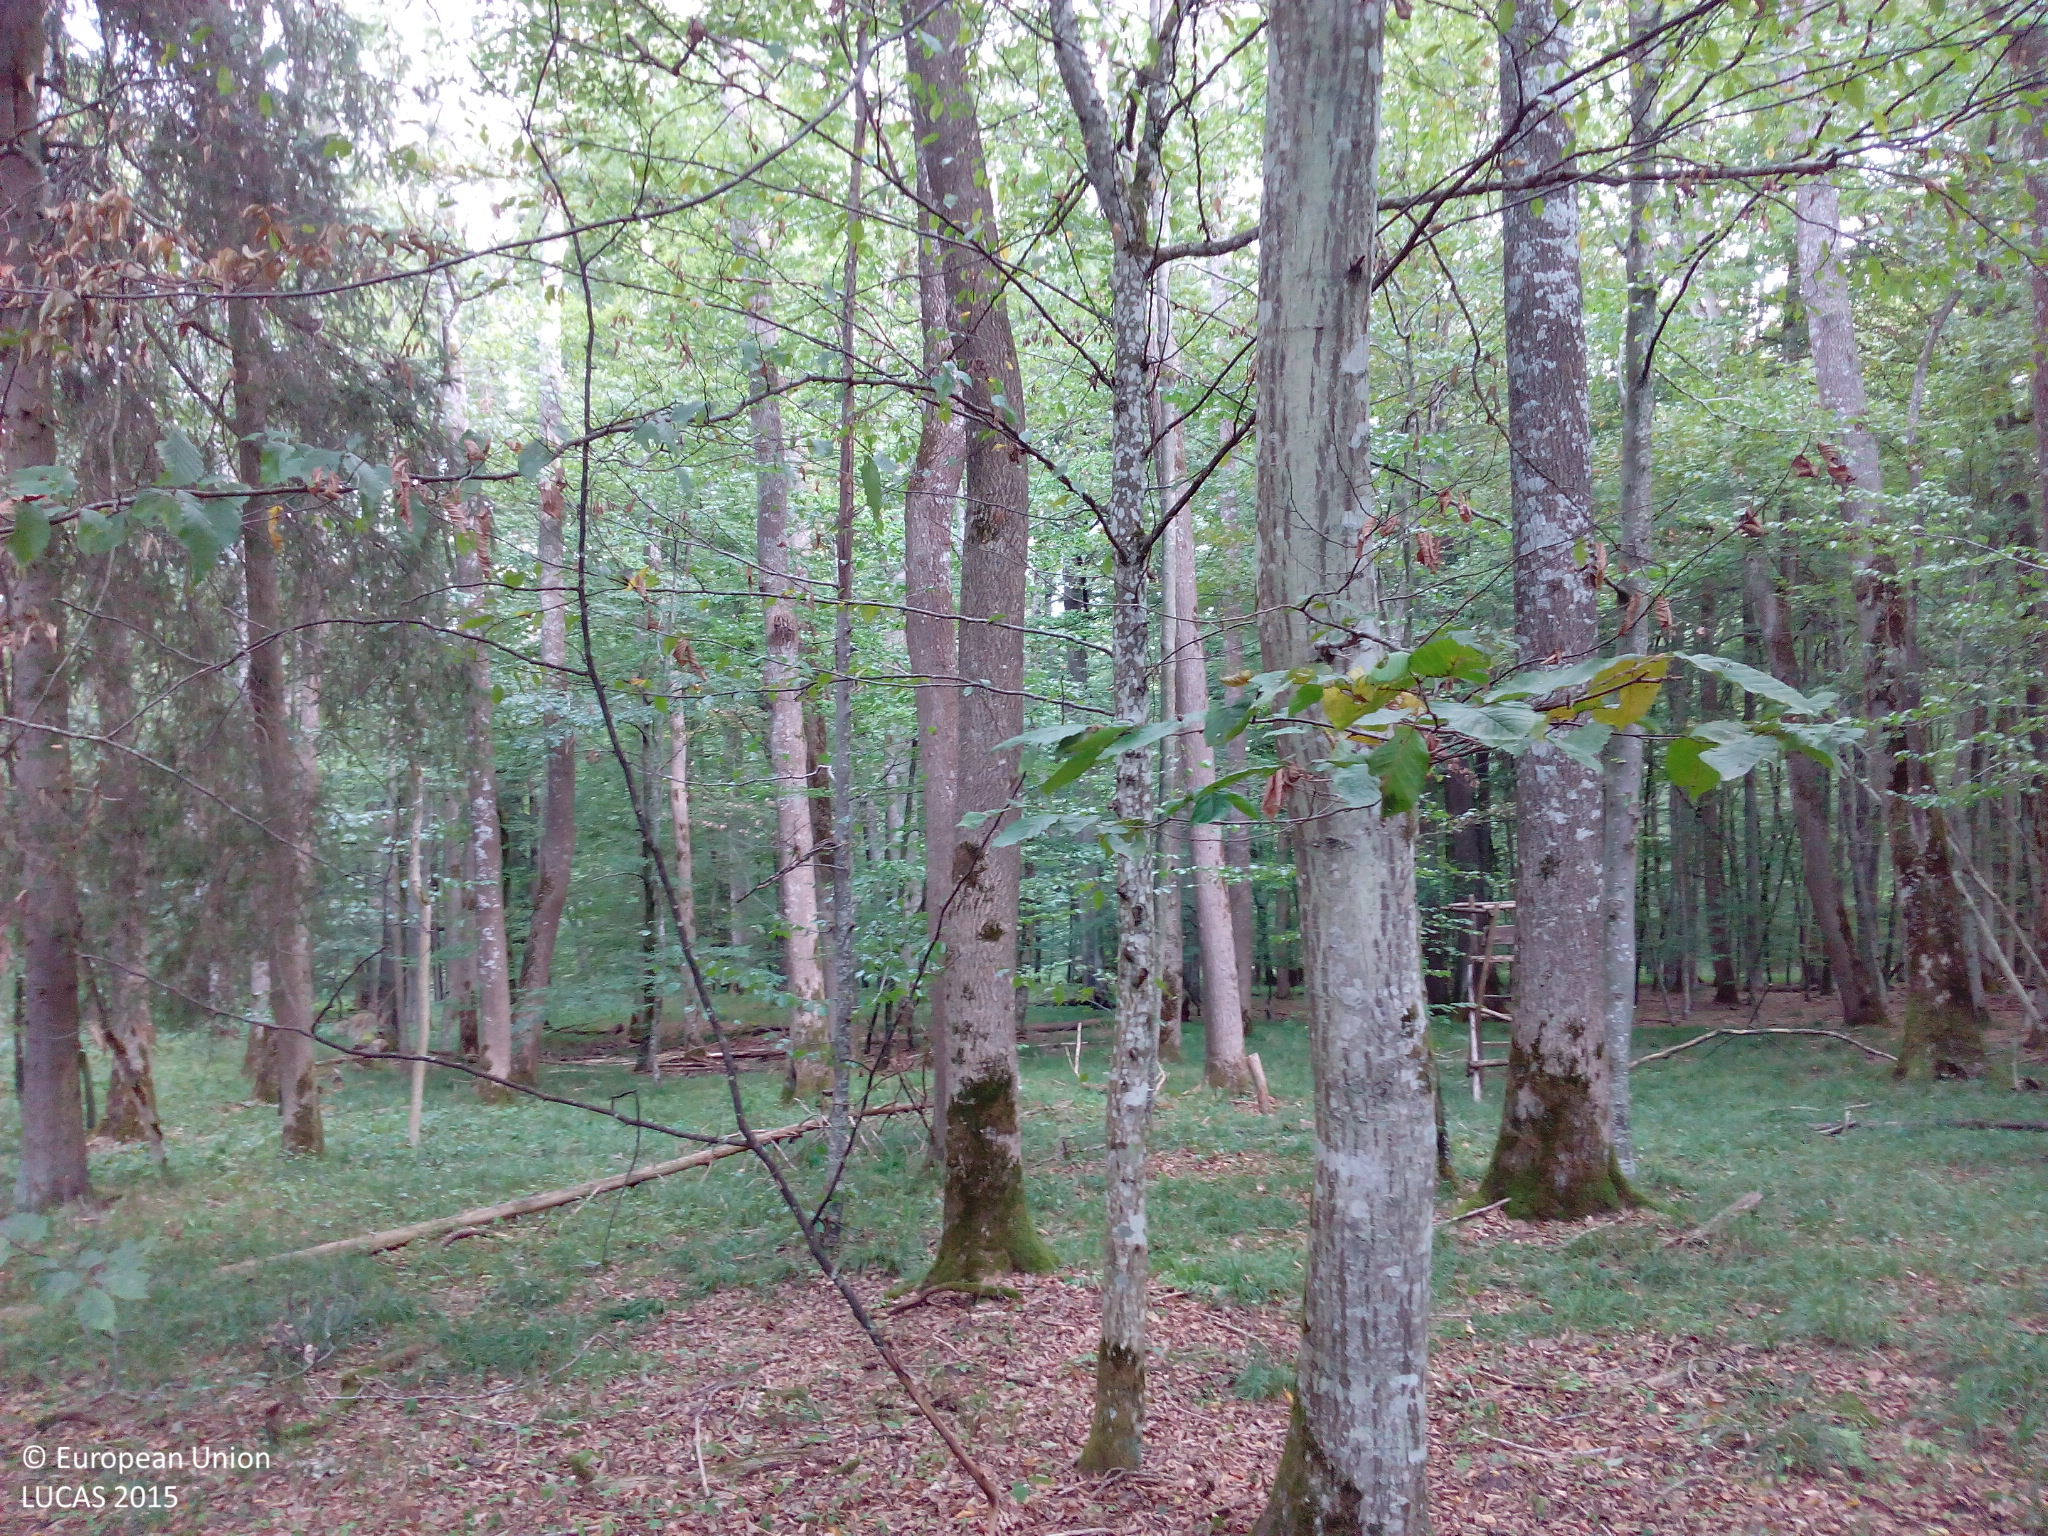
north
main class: Woodland
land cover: Broadleaved woodland
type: mesophytic deciduous forest
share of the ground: > 75 %
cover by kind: broadleaved forest trees 80 %, coniferous forest trees 10 %, unconsolidated bare surface 10 %
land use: Forestry
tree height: > 5 m
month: September
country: DE
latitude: 48.6721
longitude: 10.5293
